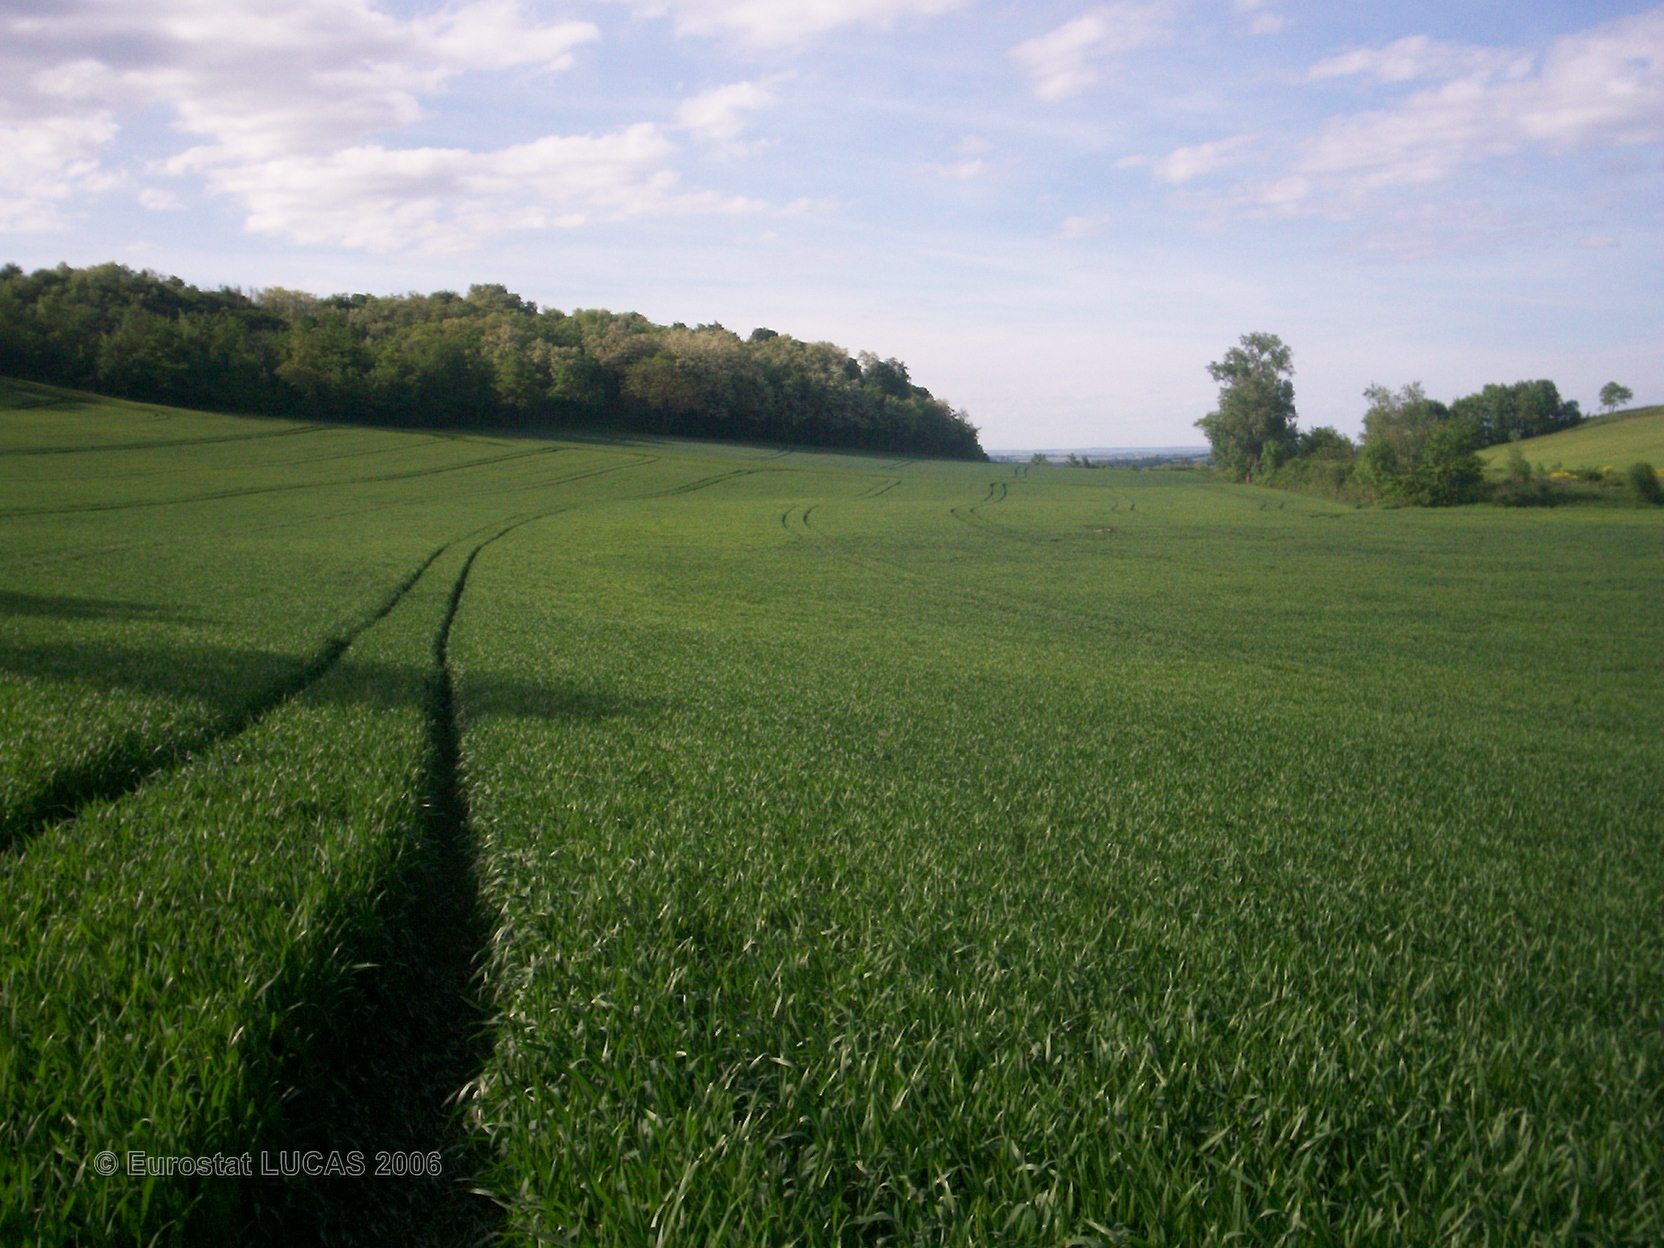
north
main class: Cropland
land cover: Triticale
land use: Agriculture (excluding fallow land and kitchen gardens)
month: May
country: FR
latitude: 45.7600
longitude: 3.2762
